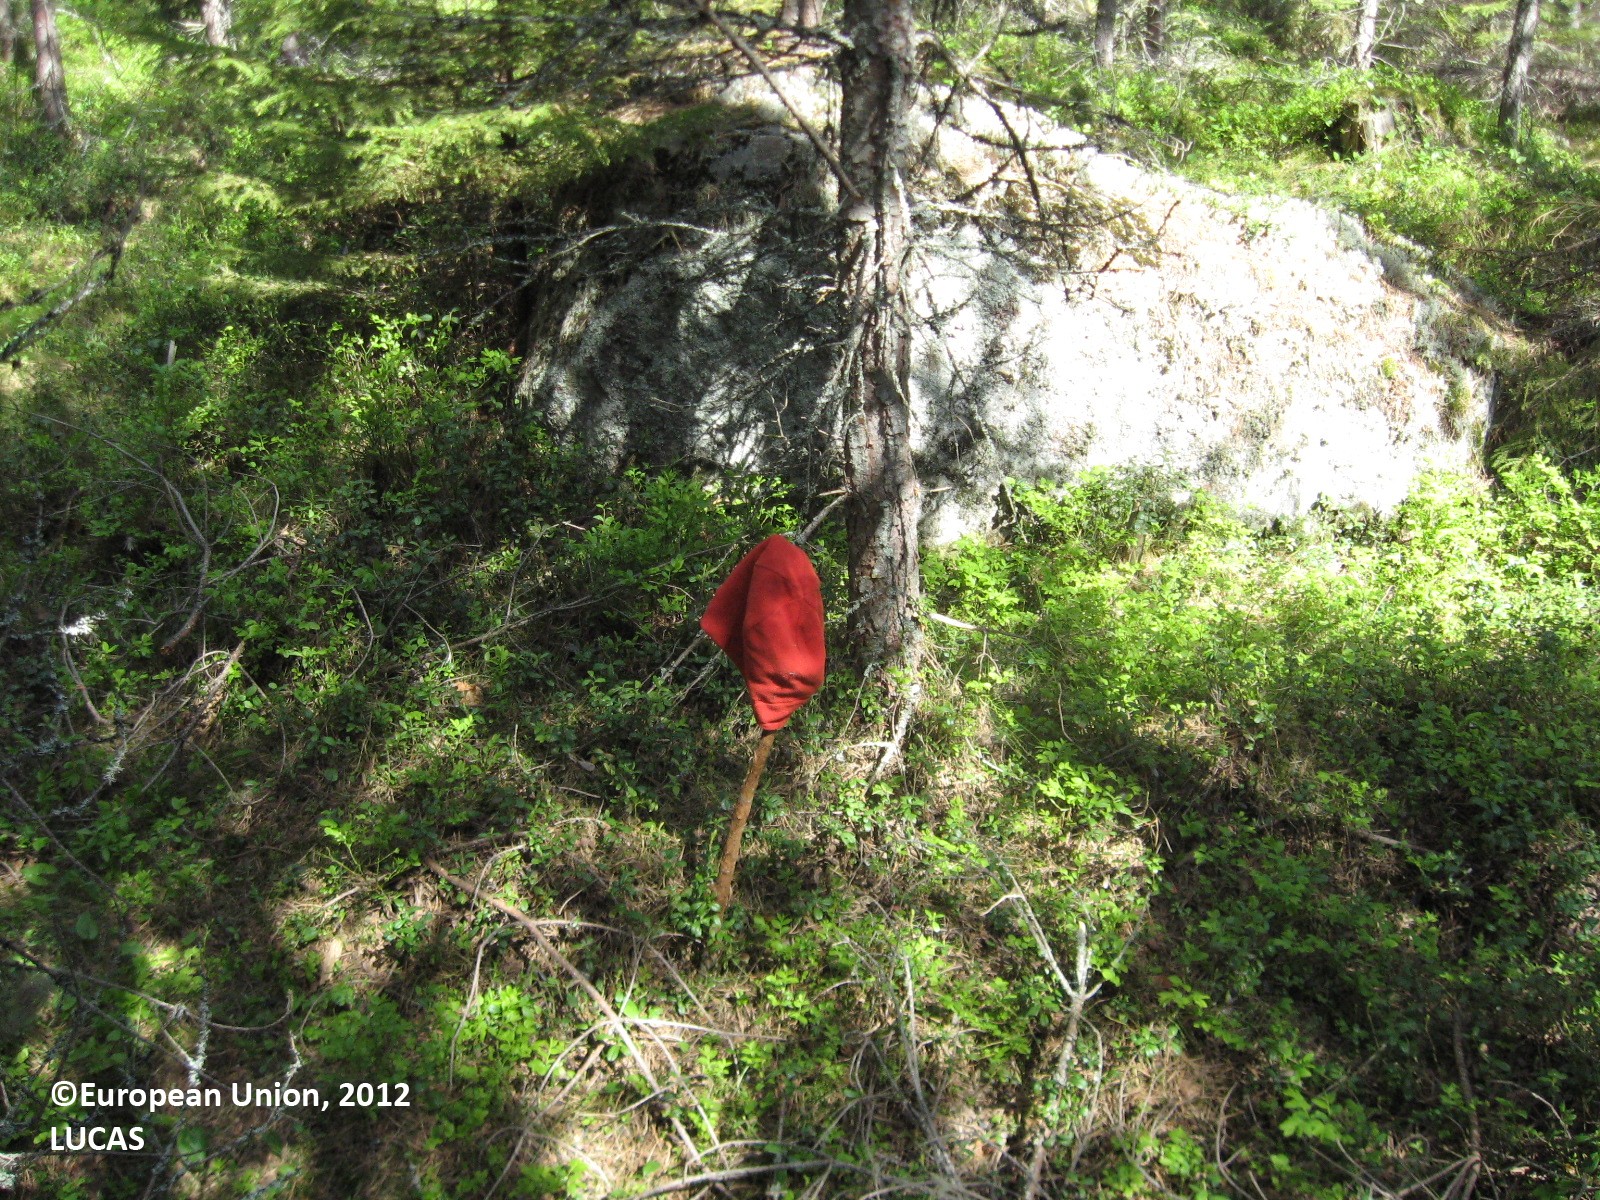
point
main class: Woodland
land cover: Pine dominated coniferous woodland
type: boreal forest
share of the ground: > 75 %
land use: Forestry
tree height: > 5 m
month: June
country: FI
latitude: 63.2161
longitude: 21.4346
